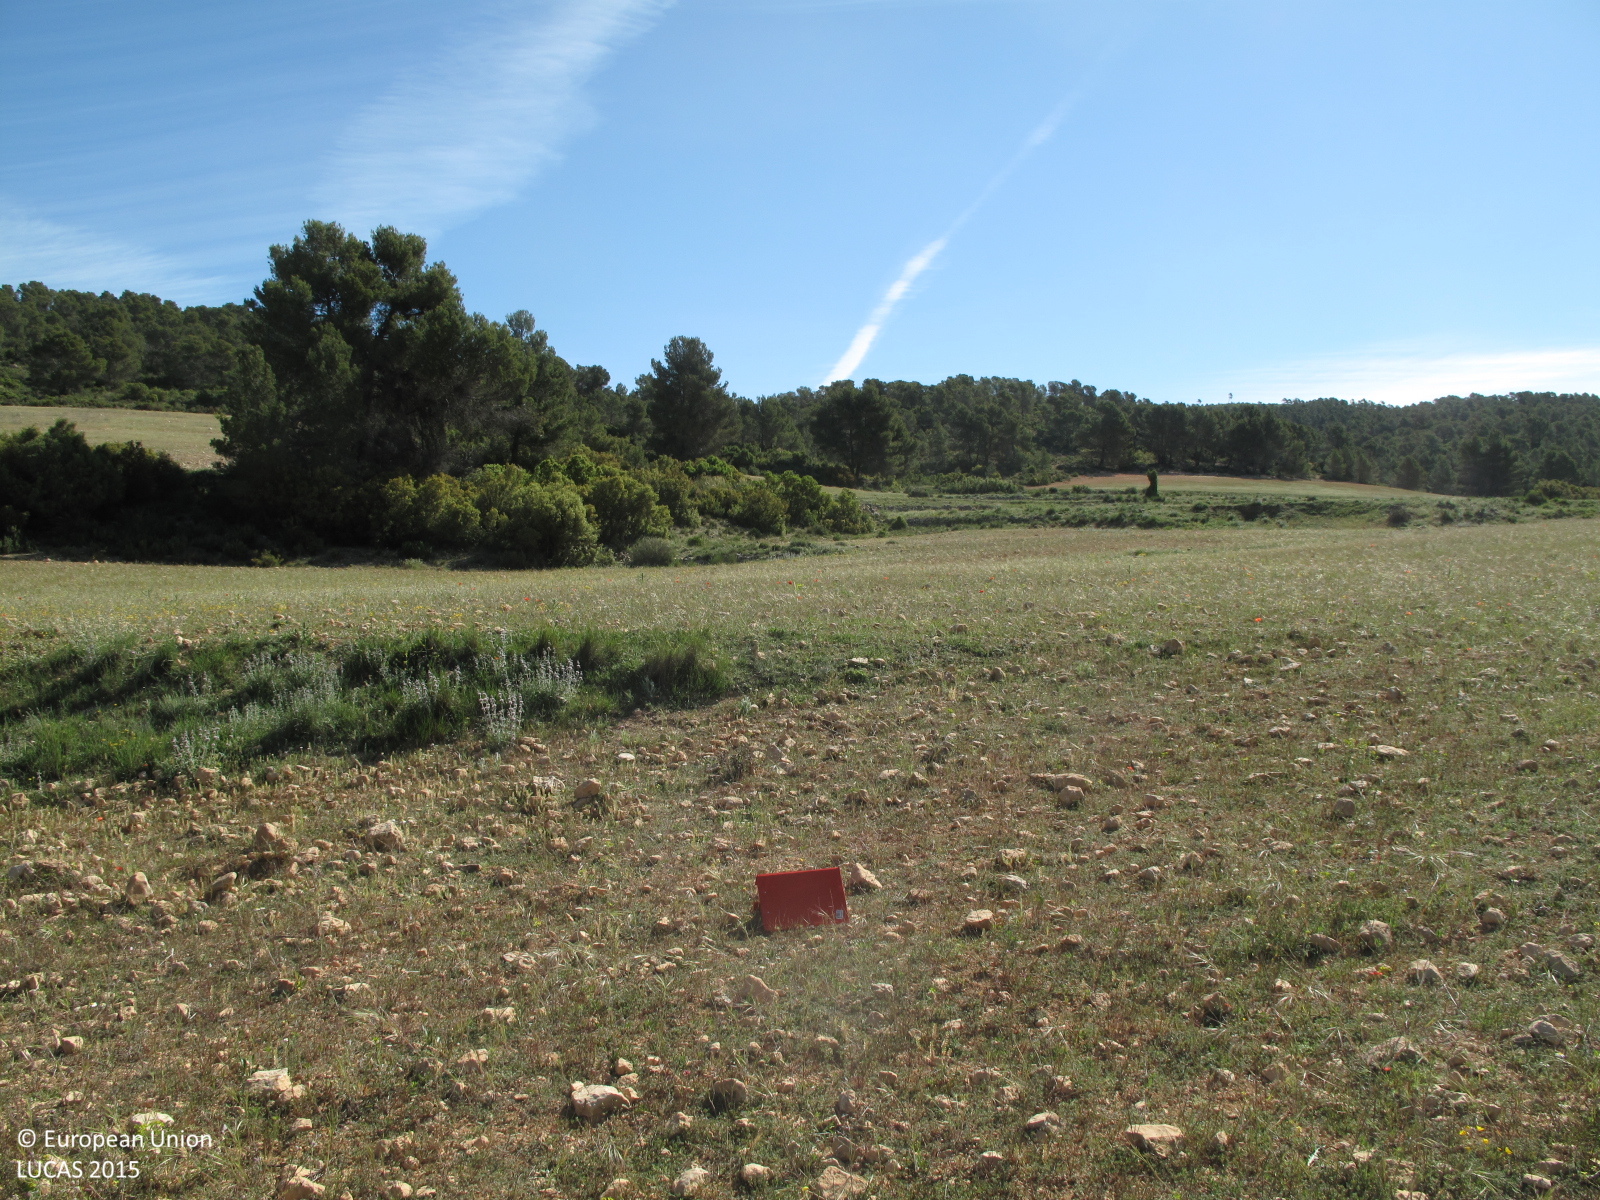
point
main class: Grassland
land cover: Spontaneously vegetated surfaces
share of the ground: 50 - 75 %
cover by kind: herbaceous plants 70 %, unconsolidated bare surface 30 %
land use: Fallow land
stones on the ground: 25 - 50 %
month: May
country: ES
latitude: 38.8978
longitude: -1.0053
